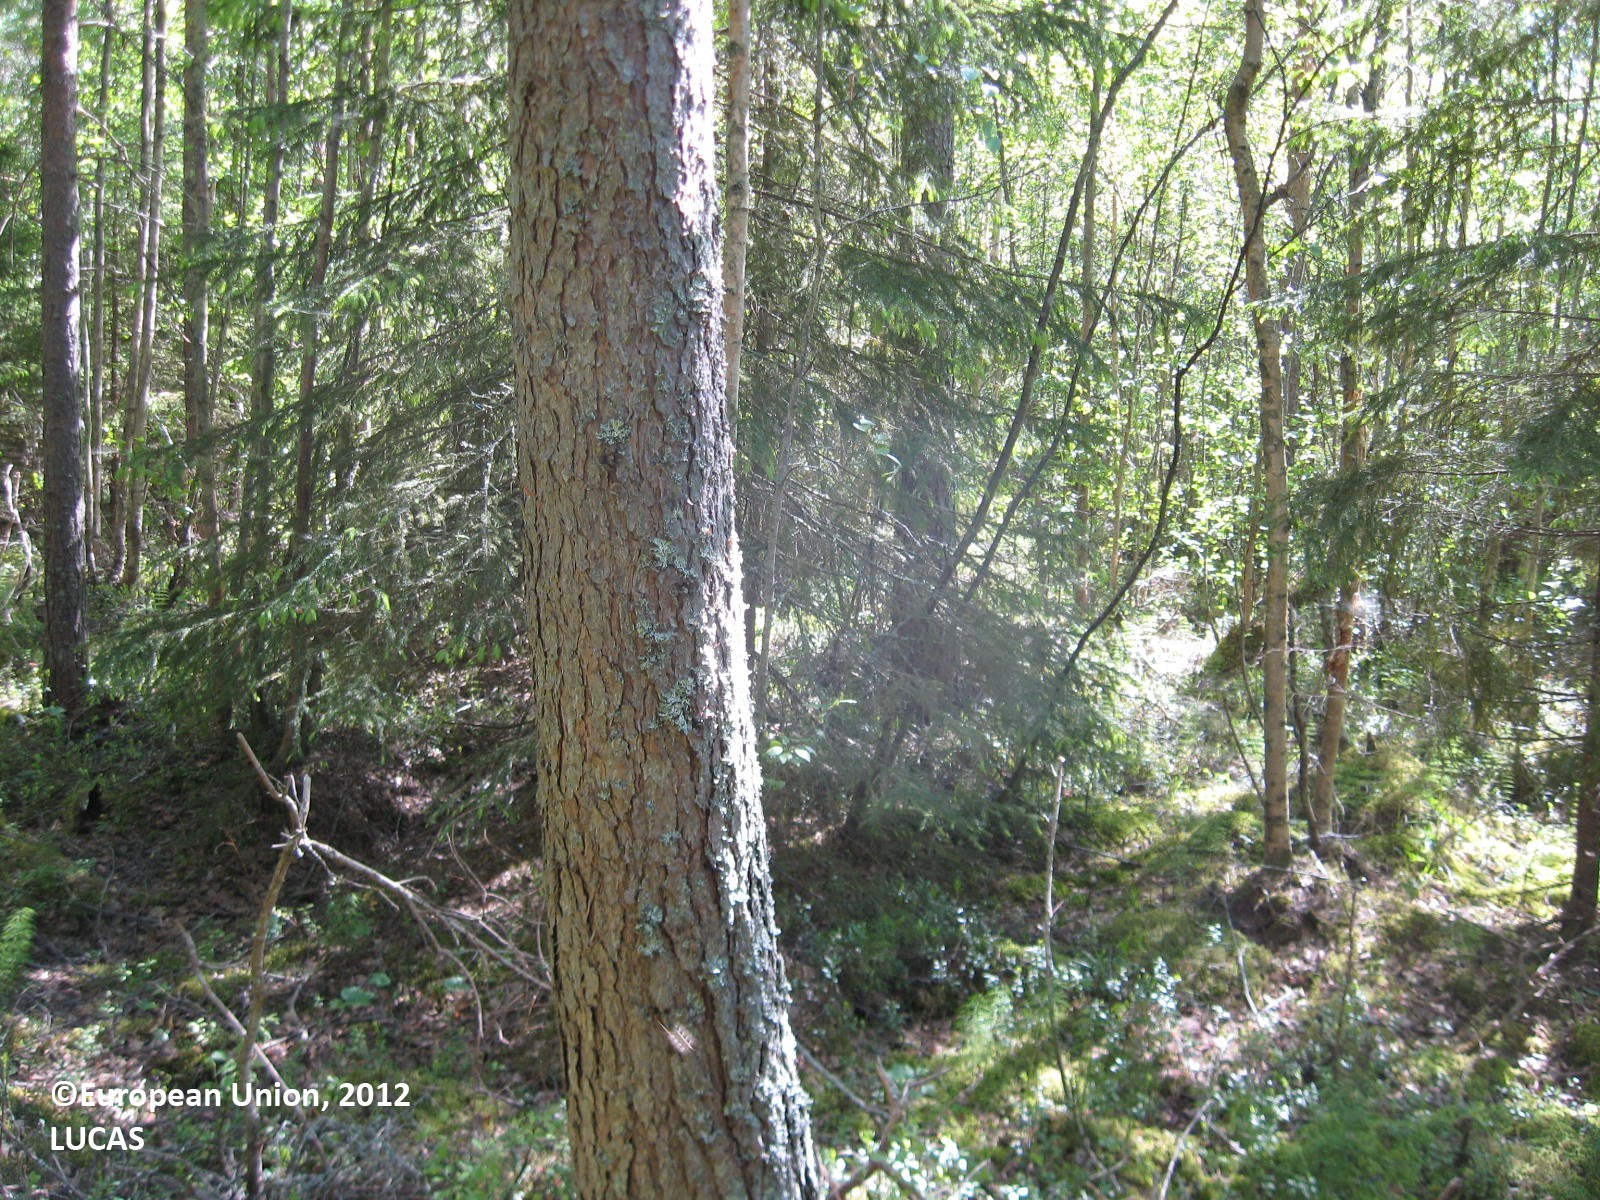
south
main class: Woodland
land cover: Other mixed woodland
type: boreal forest
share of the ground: > 75 %
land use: Forestry
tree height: > 5 m
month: June
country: FI
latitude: 62.7752
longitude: 21.2262
